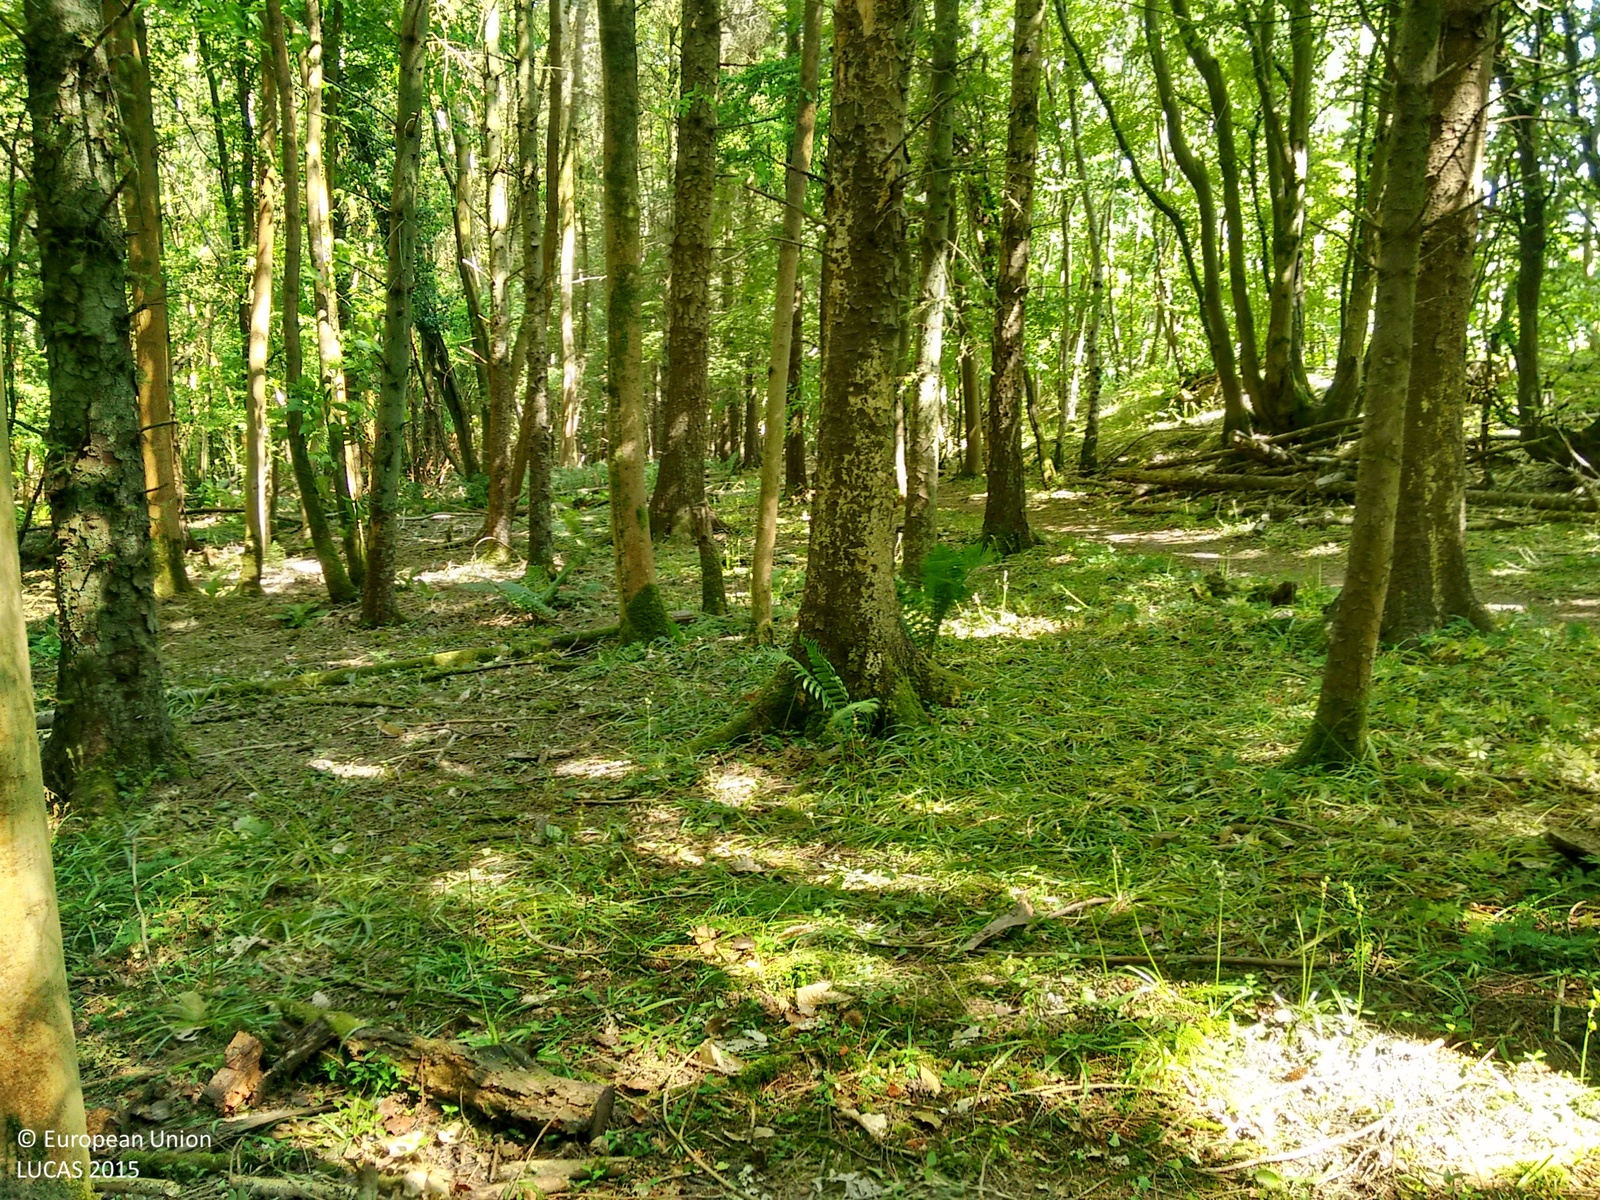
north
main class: Woodland
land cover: Other mixed woodland
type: exotic forest
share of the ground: > 75 %
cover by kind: coniferous forest trees 50 %, broadleaved forest trees 50 %
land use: Forestry
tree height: > 5 m
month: June
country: GB
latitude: 50.9818
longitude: 0.4998
